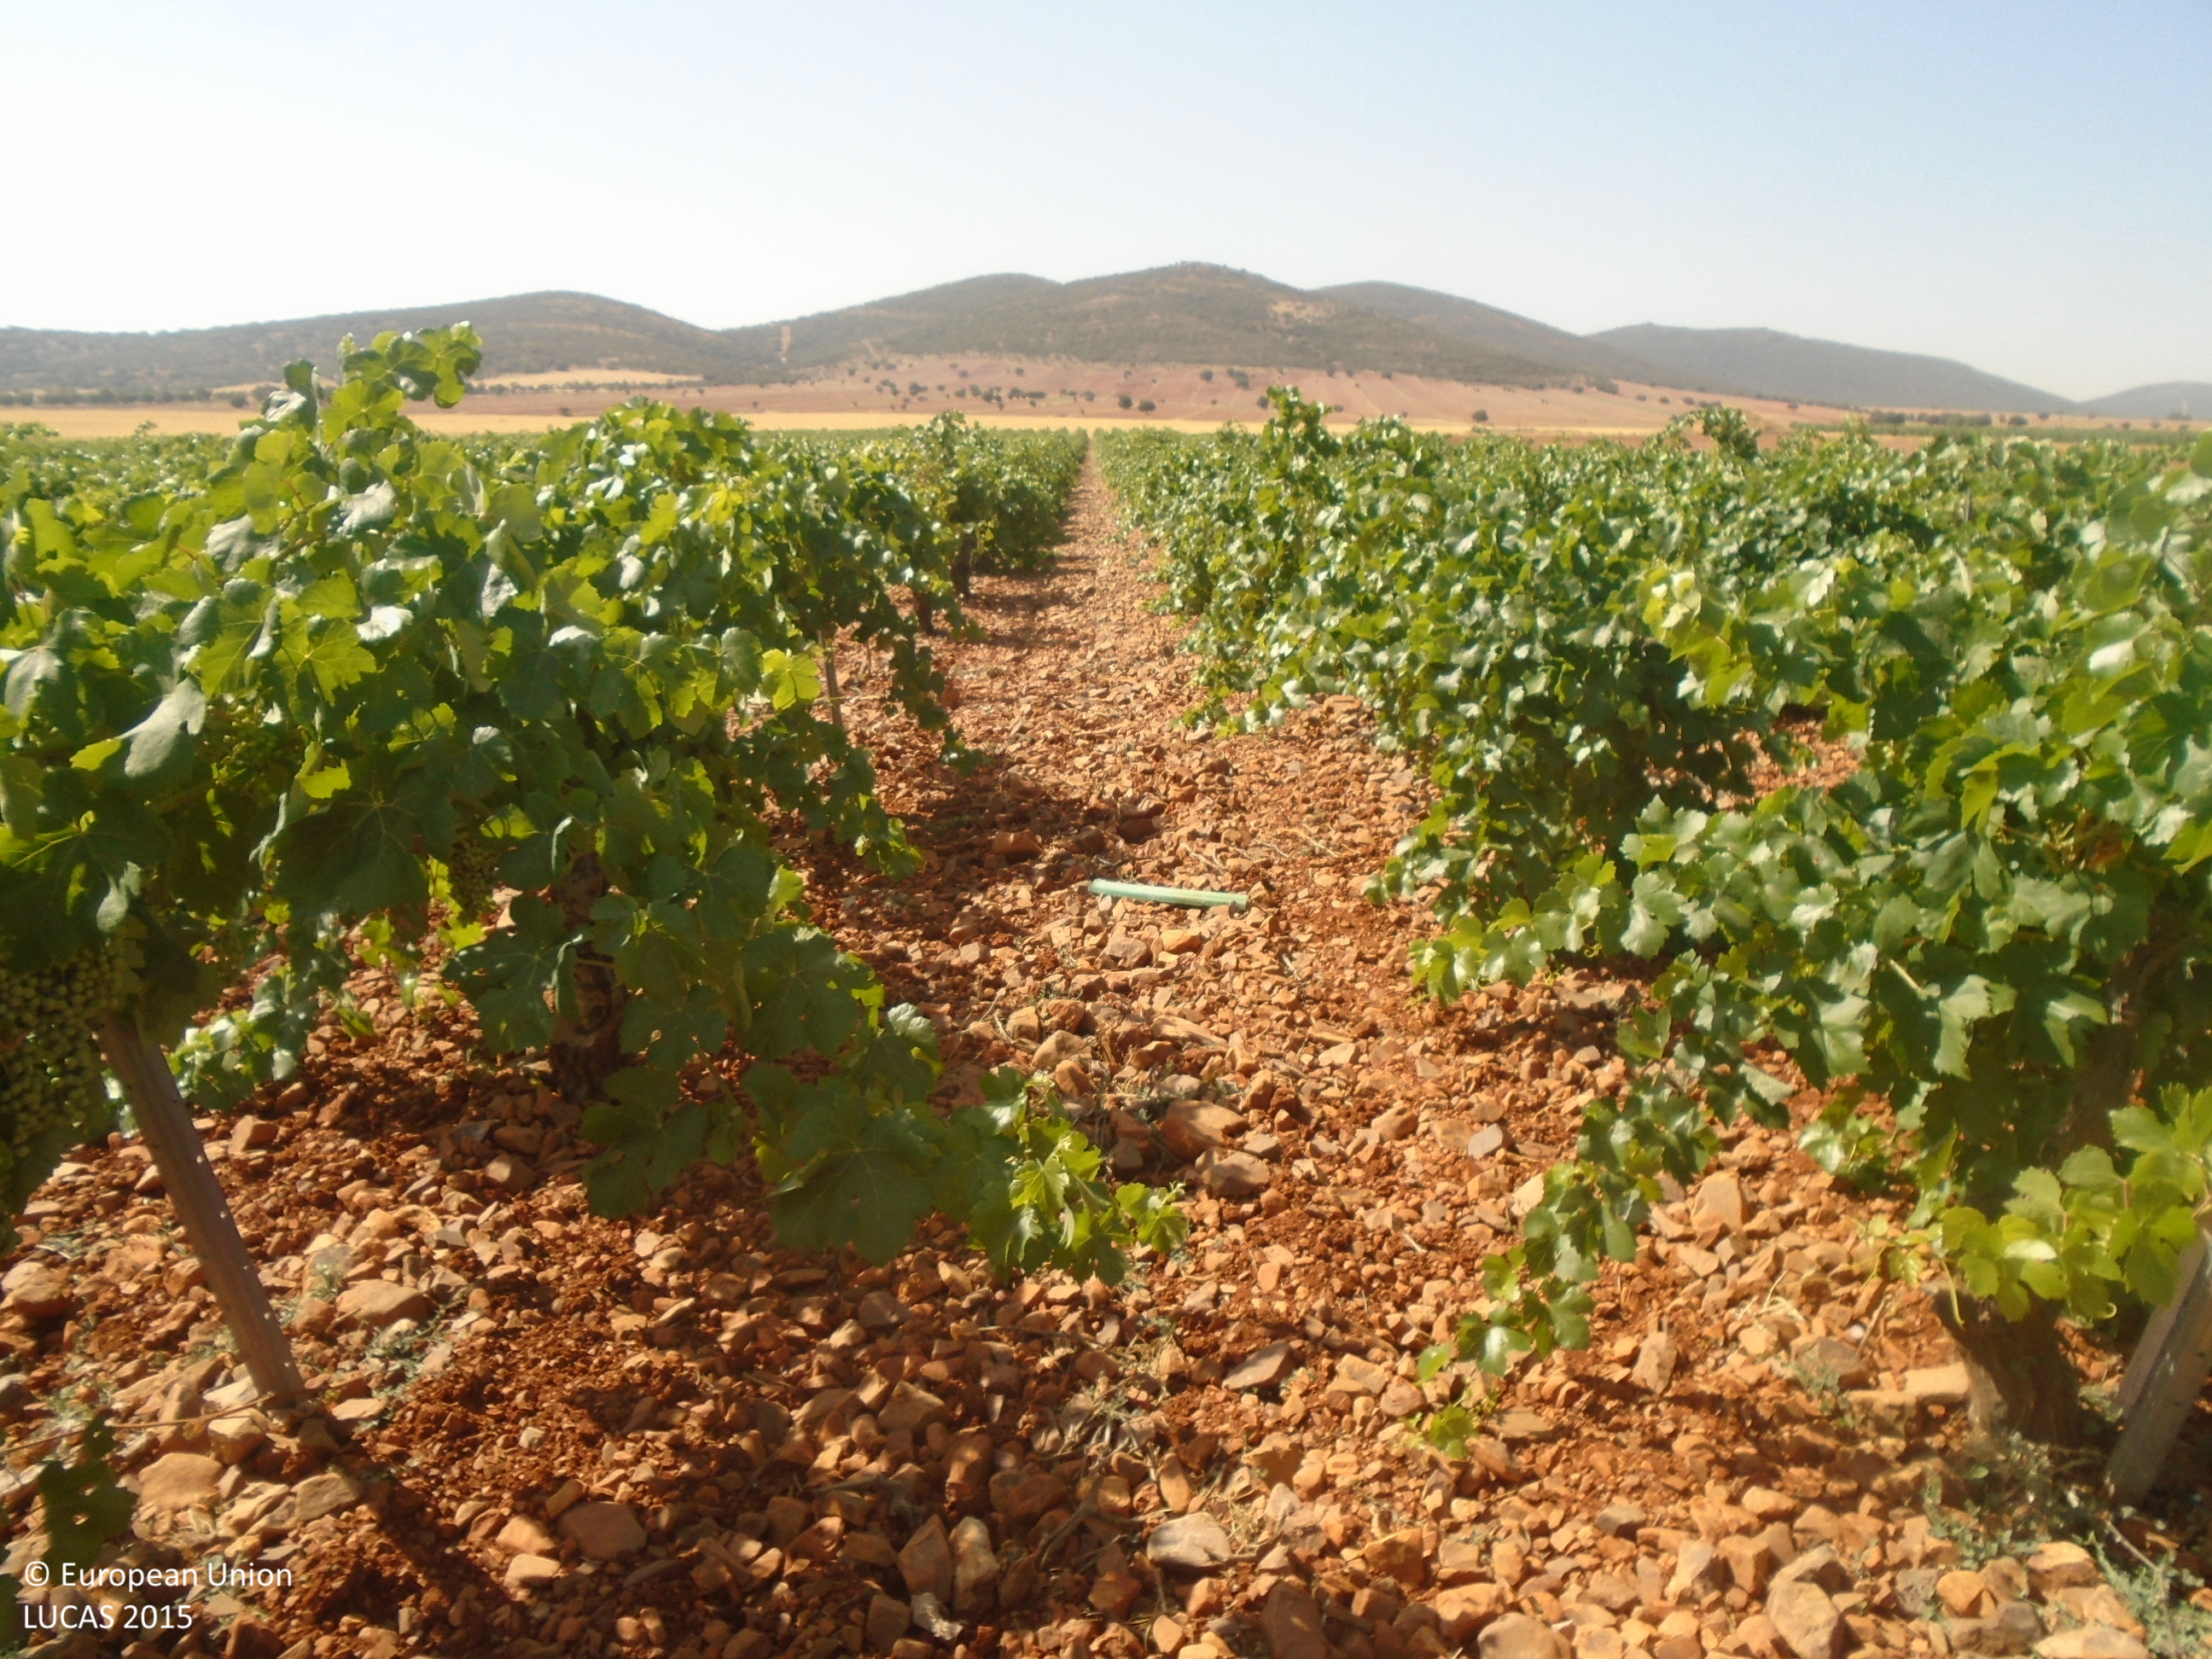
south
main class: Cropland
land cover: Vineyards
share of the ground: 25 - 50 %
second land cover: Other bare soil
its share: > 75 %
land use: Agriculture (excluding fallow land and kitchen gardens)
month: July
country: ES
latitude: 39.3975
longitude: -3.6673
